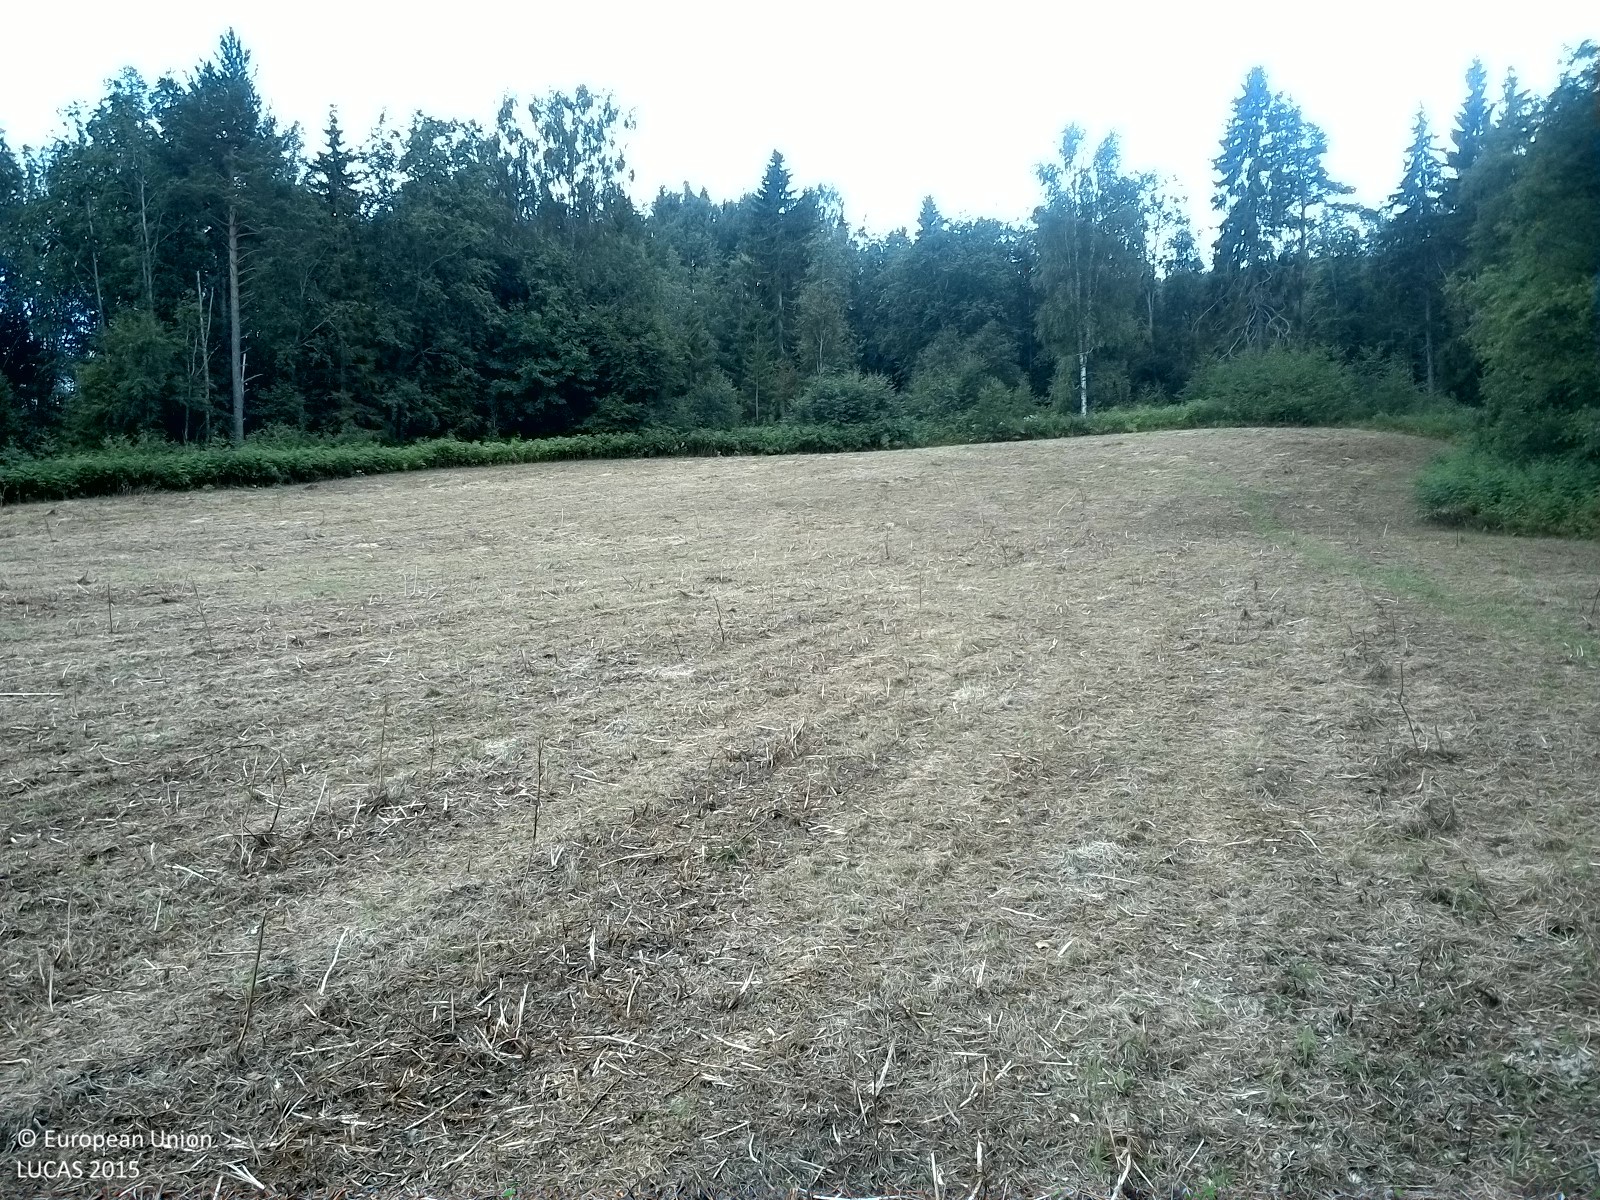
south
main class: Grassland
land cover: Spontaneously vegetated surfaces
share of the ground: < 10 %
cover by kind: herbaceous plants 10 %, unconsolidated bare surface 10 %
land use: Agriculture (excluding fallow land and kitchen gardens)
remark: Harvested field
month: August
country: SE
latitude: 62.5527
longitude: 17.1163
